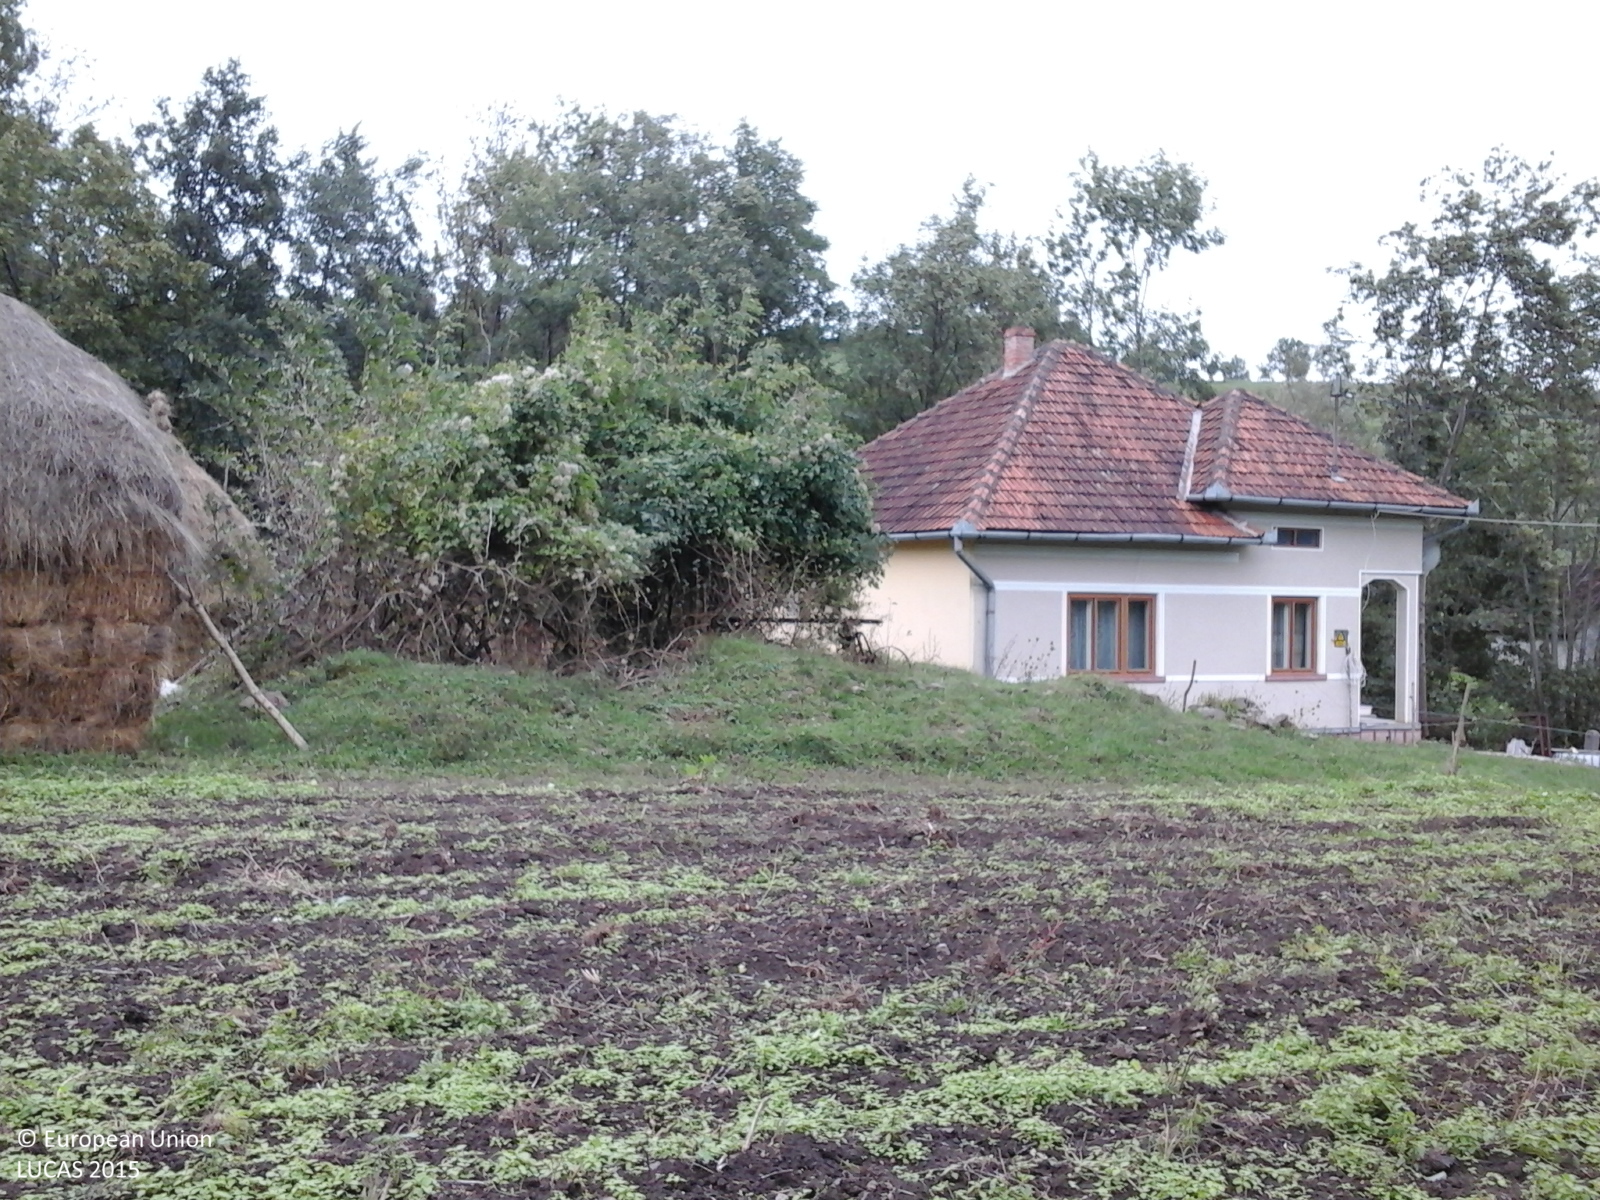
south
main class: Cropland
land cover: Maize
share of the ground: < 10 %
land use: Agriculture (excluding fallow land and kitchen gardens)
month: September
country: RO
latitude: 45.9555
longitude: 22.9966
